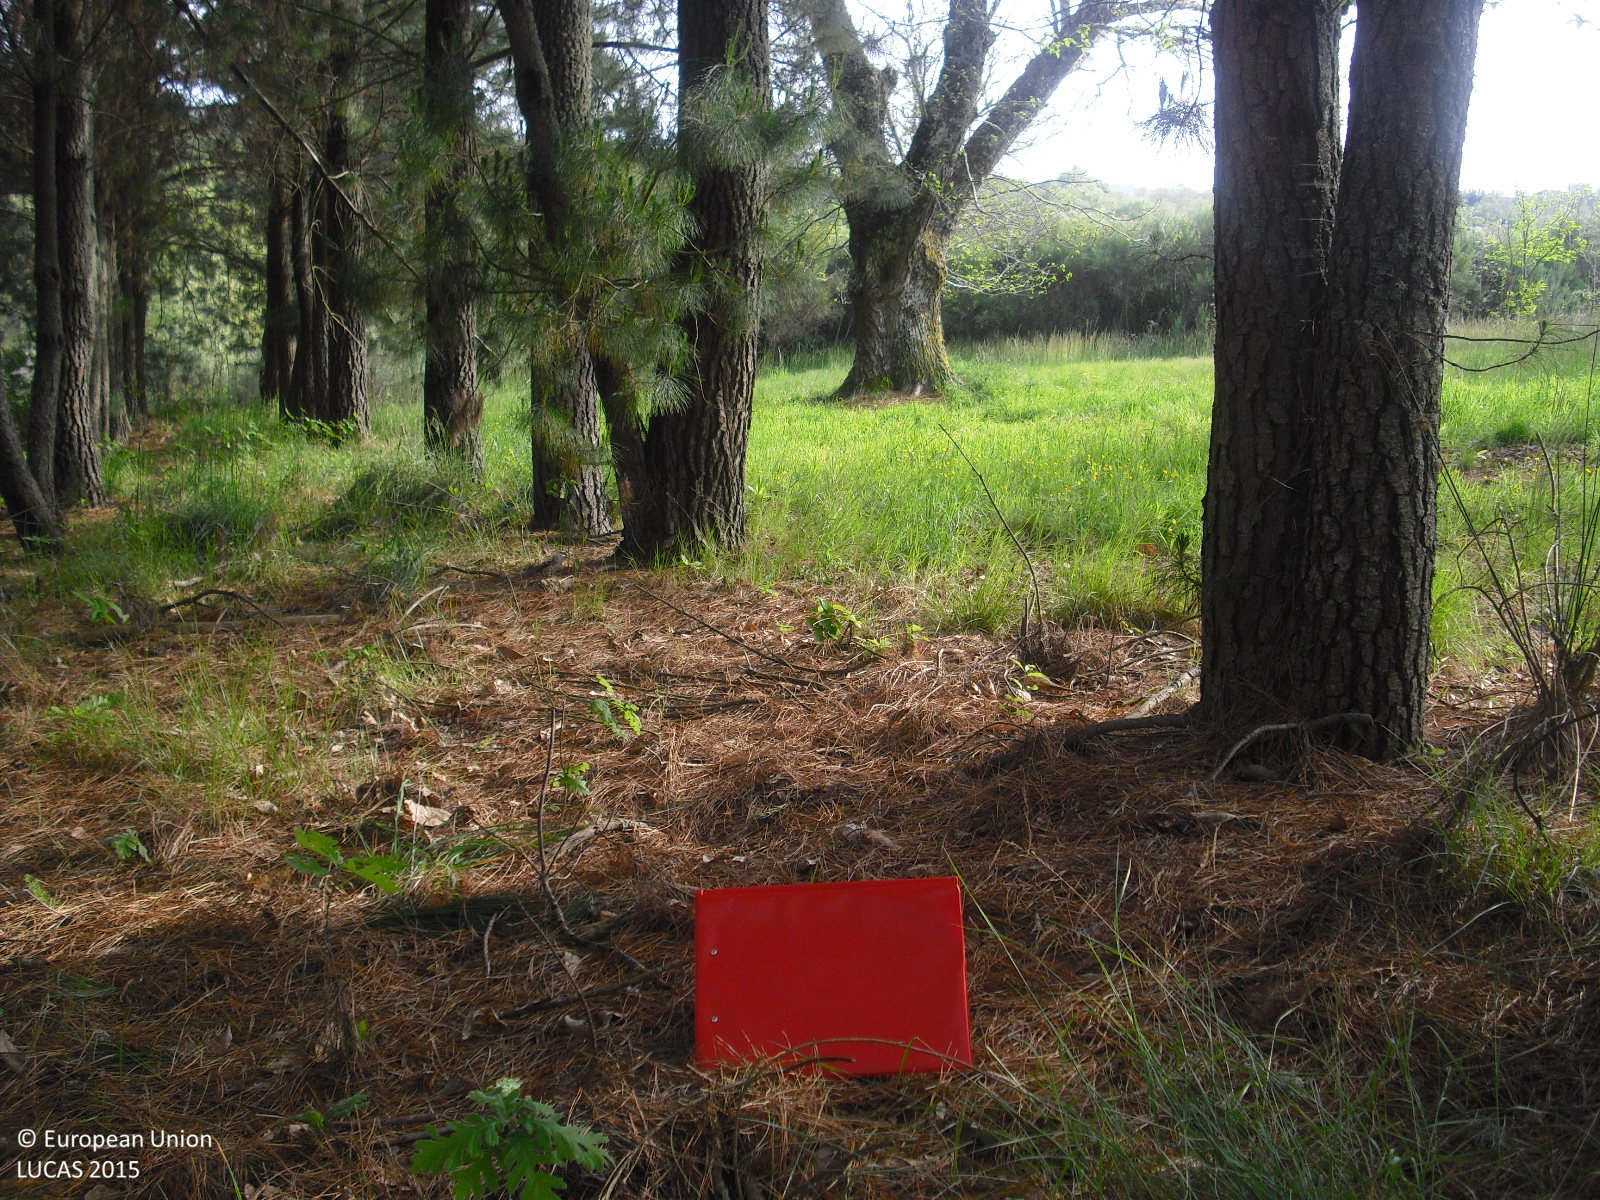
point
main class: Woodland
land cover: Pine dominated coniferous woodland
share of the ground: > 75 %
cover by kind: coniferous forest trees 100 %
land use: Forestry
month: May
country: ES
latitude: 41.9455
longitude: -7.2936
